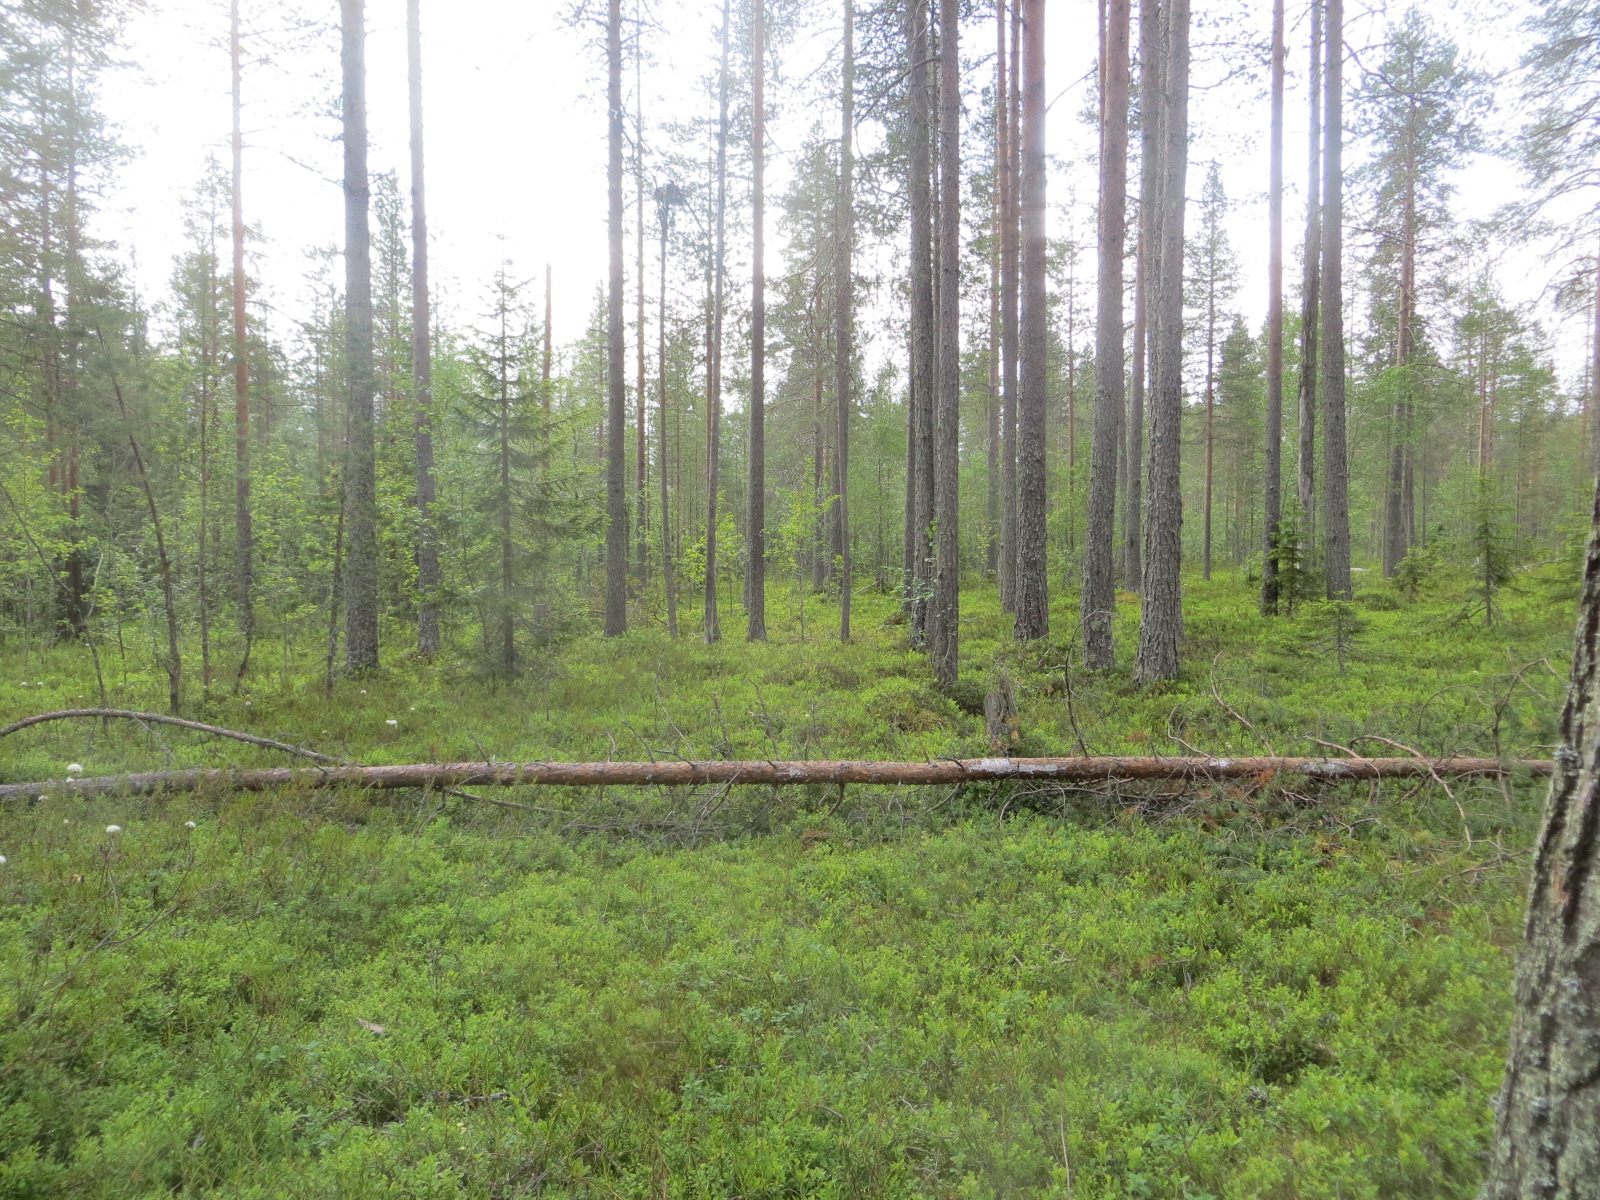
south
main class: Woodland
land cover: Pine dominated coniferous woodland
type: boreal forest
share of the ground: 50 - 75 %
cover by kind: coniferous forest trees 50 %, shrubs 45 %, broadleaved forest trees 5 %
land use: Forestry
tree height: > 5 m
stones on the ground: 25 - 50 %
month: July
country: FI
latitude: 66.3315
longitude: 25.9024
